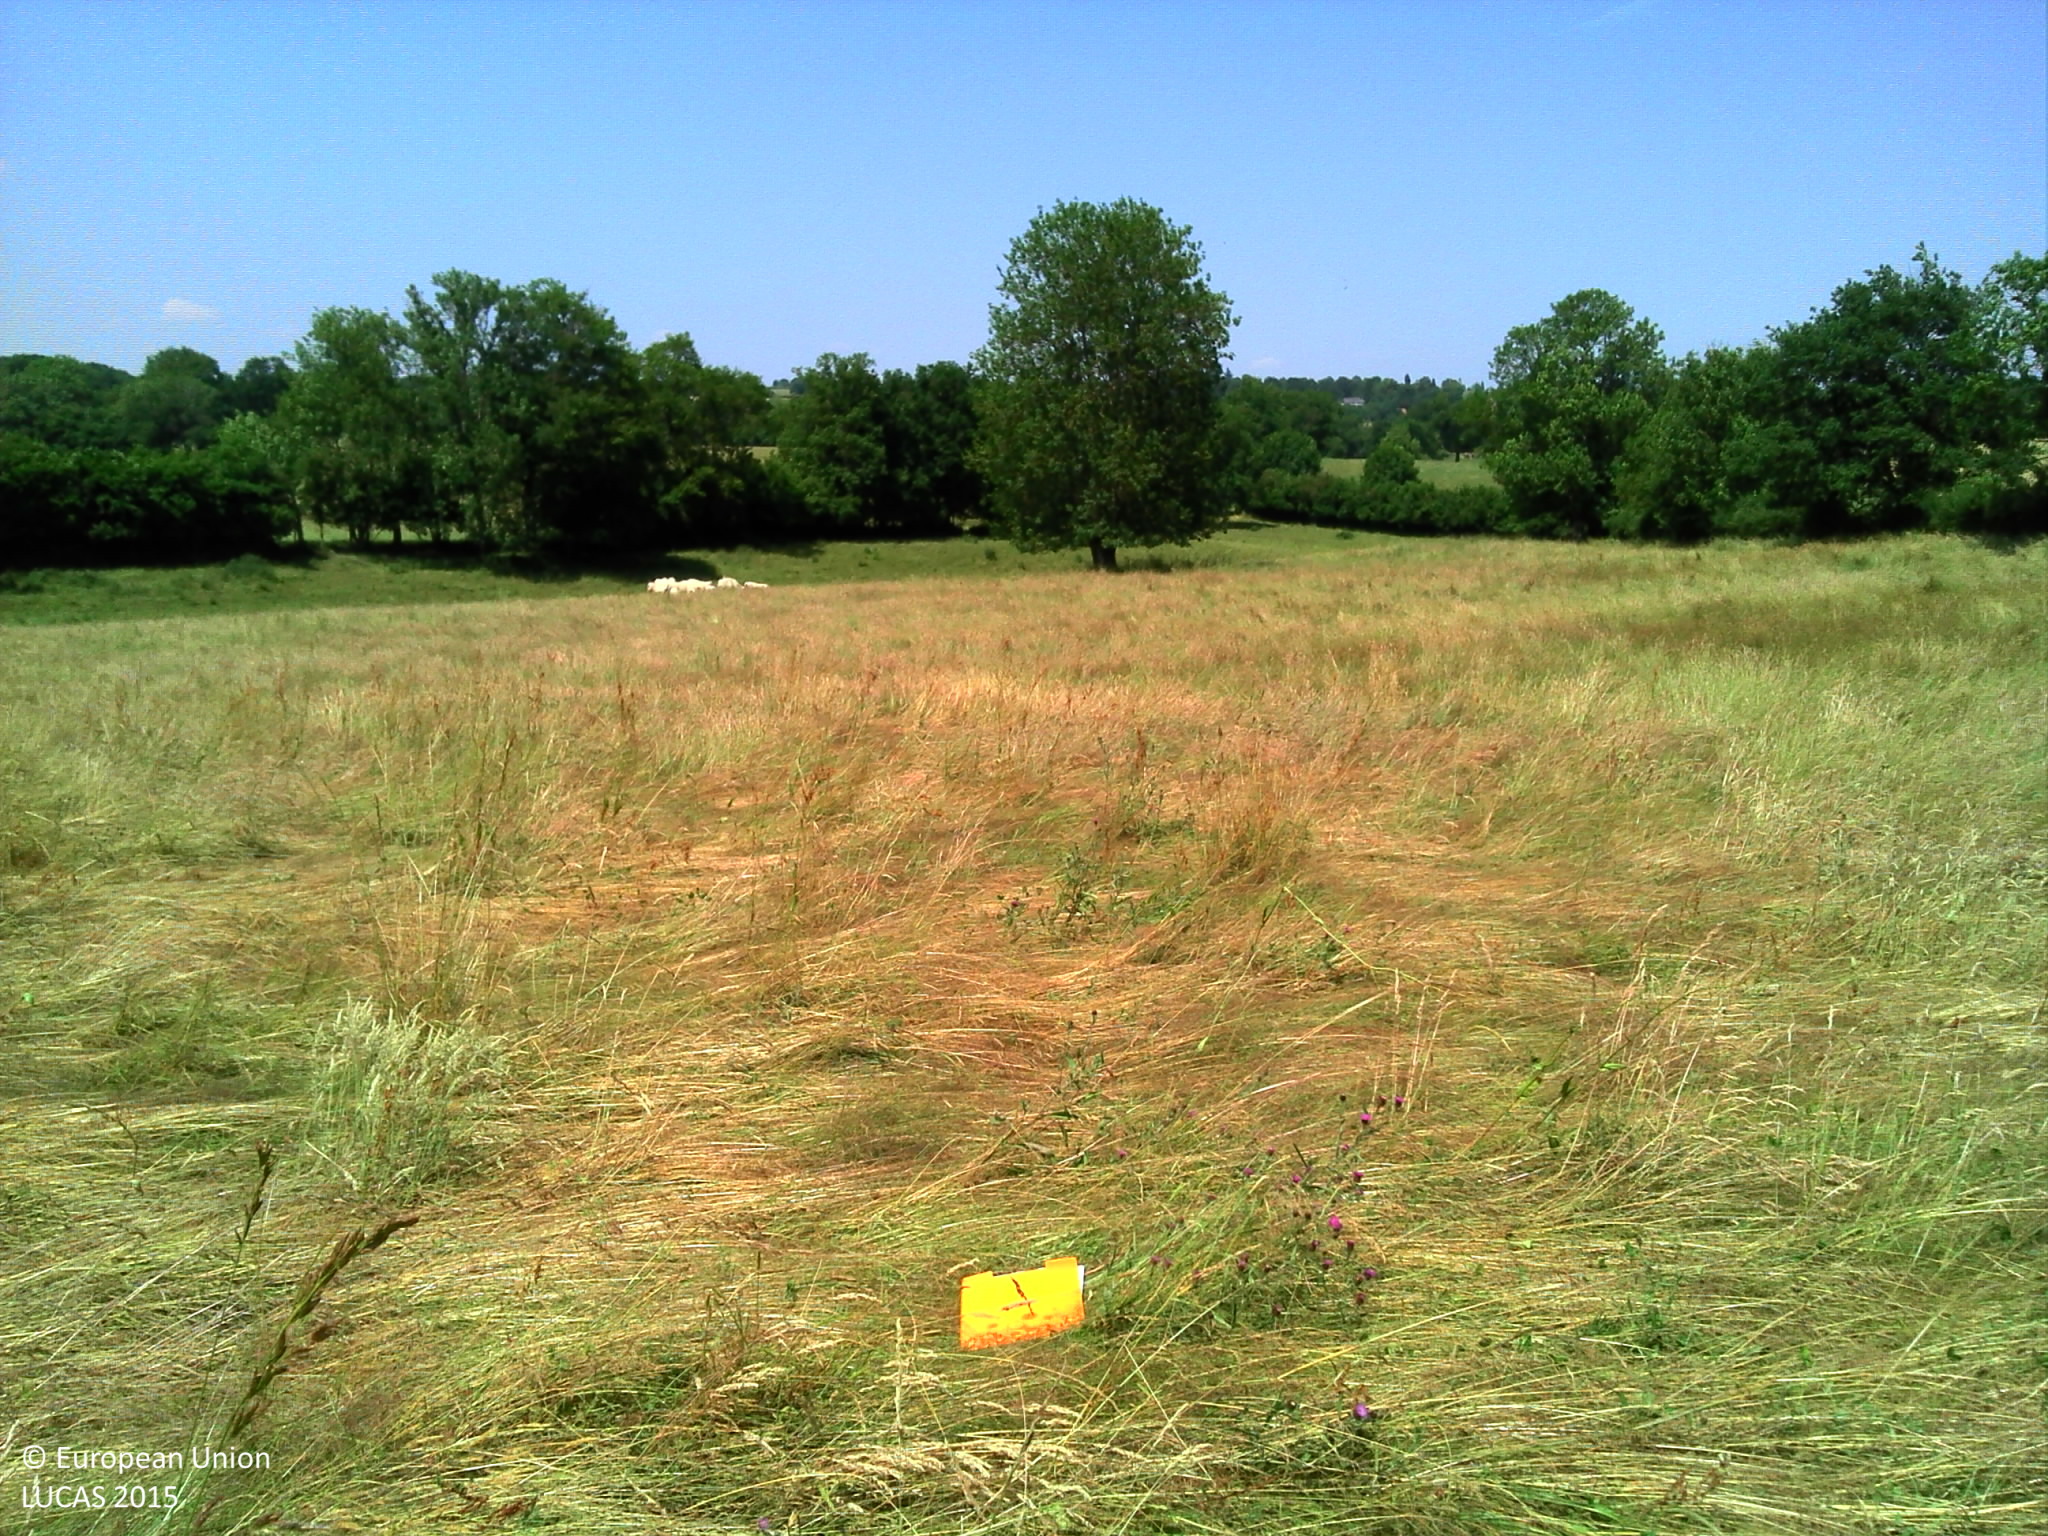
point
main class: Grassland
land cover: Grassland without tree/shrub cover
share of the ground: > 75 %
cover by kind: herbaceous plants 100 %
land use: Agriculture (excluding fallow land and kitchen gardens)
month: June
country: FR
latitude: 46.3400
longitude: 3.0209
